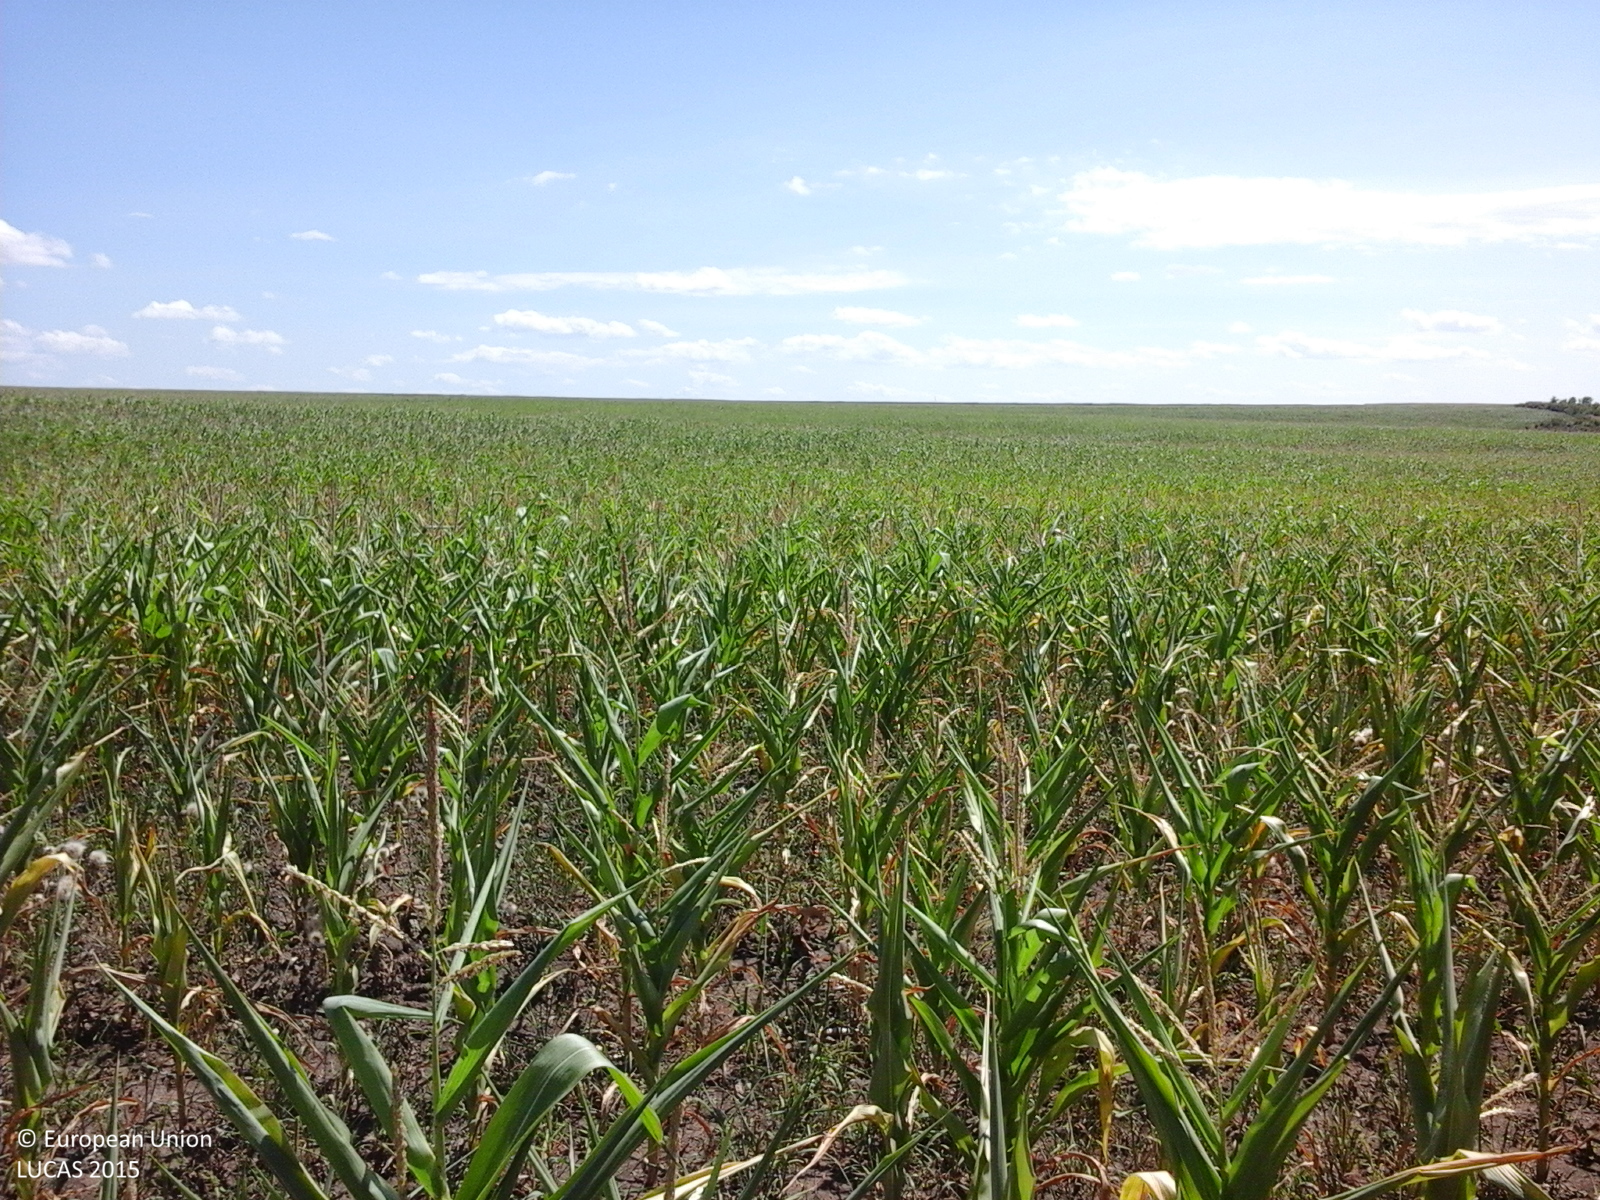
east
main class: Cropland
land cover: Maize
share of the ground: > 75 %
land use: Agriculture (excluding fallow land and kitchen gardens)
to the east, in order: Maize
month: July
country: RO
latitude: 45.9433
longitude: 27.7204
